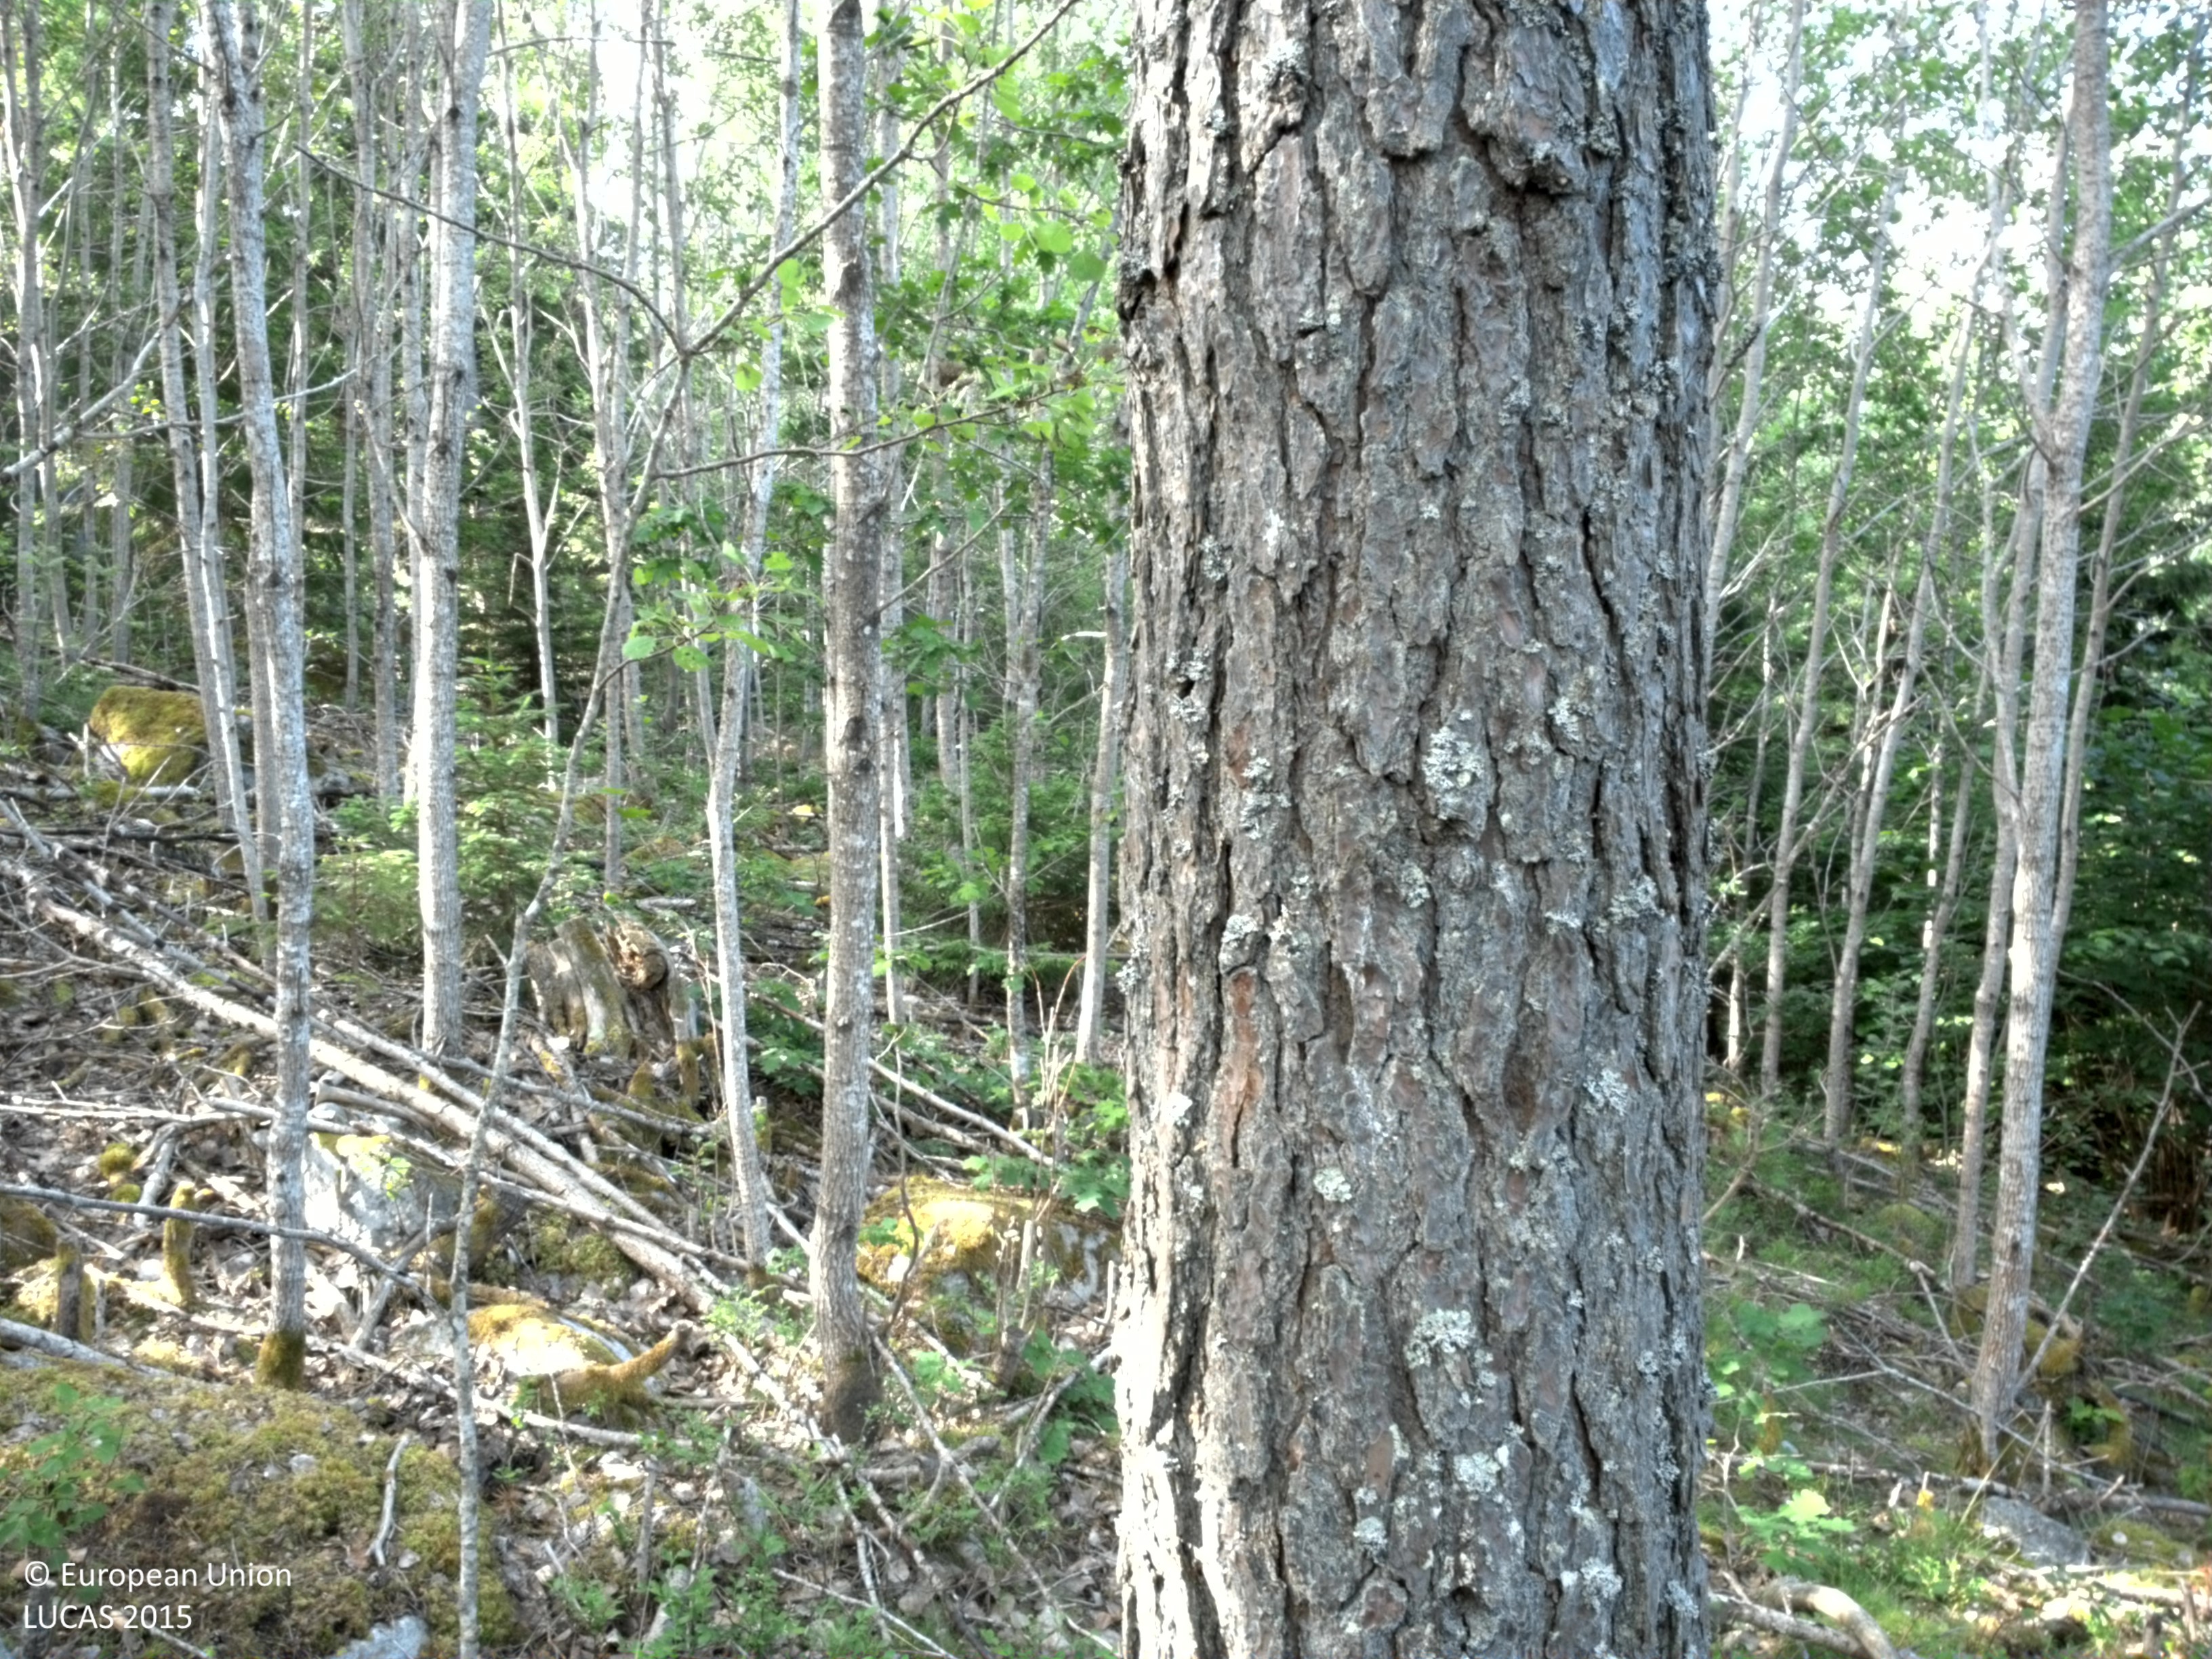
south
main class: Woodland
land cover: Pine dominated mixed woodland
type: boreal forest
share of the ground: > 75 %
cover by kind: coniferous forest trees 50 %, broadleaved forest trees 30 %, lichens and mosses 20 %
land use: Forestry
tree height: > 5 m
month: July
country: SE
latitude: 59.8063
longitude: 18.6451
